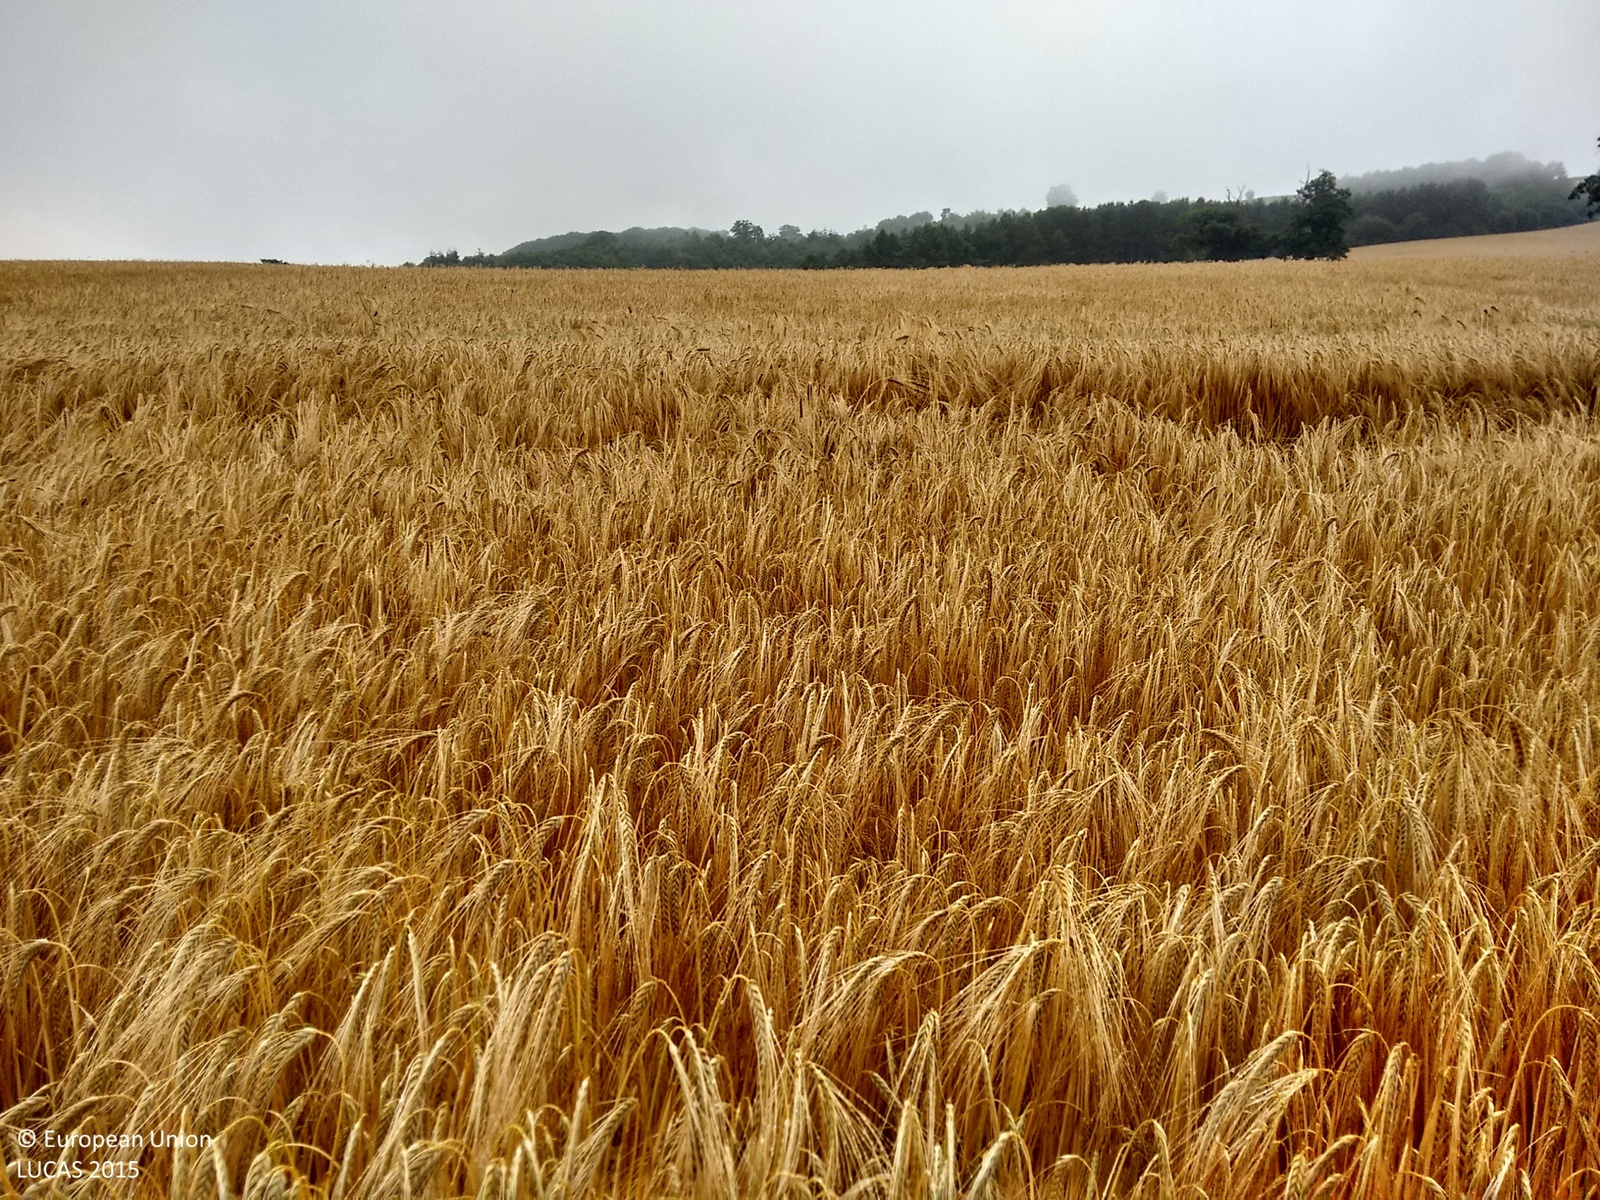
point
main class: Cropland
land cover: Barley
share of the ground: > 75 %
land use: Agriculture (excluding fallow land and kitchen gardens)
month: July
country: GB
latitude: 52.3691
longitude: -2.8352
